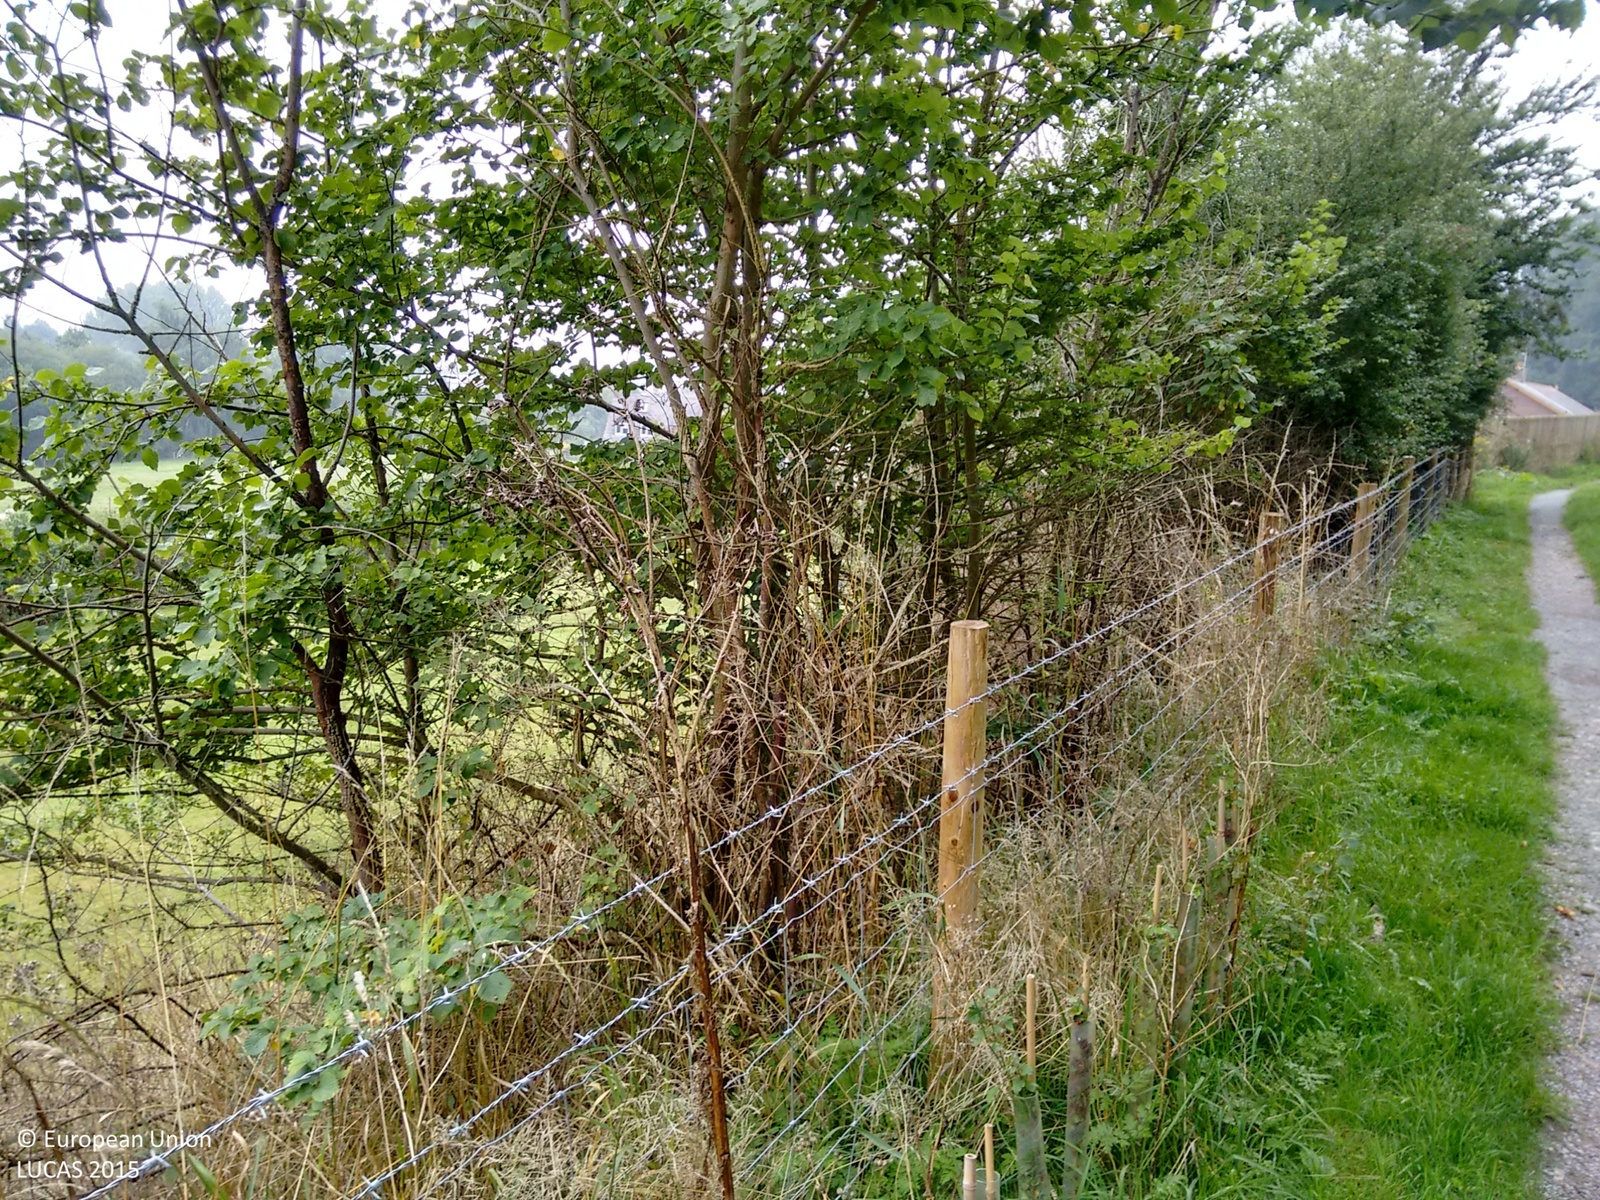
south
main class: Grassland
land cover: Grassland without tree/shrub cover
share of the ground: > 75 %
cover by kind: herbaceous plants 100 %
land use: Agriculture (excluding fallow land and kitchen gardens)
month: September
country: GB
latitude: 52.7990
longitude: -2.9025
